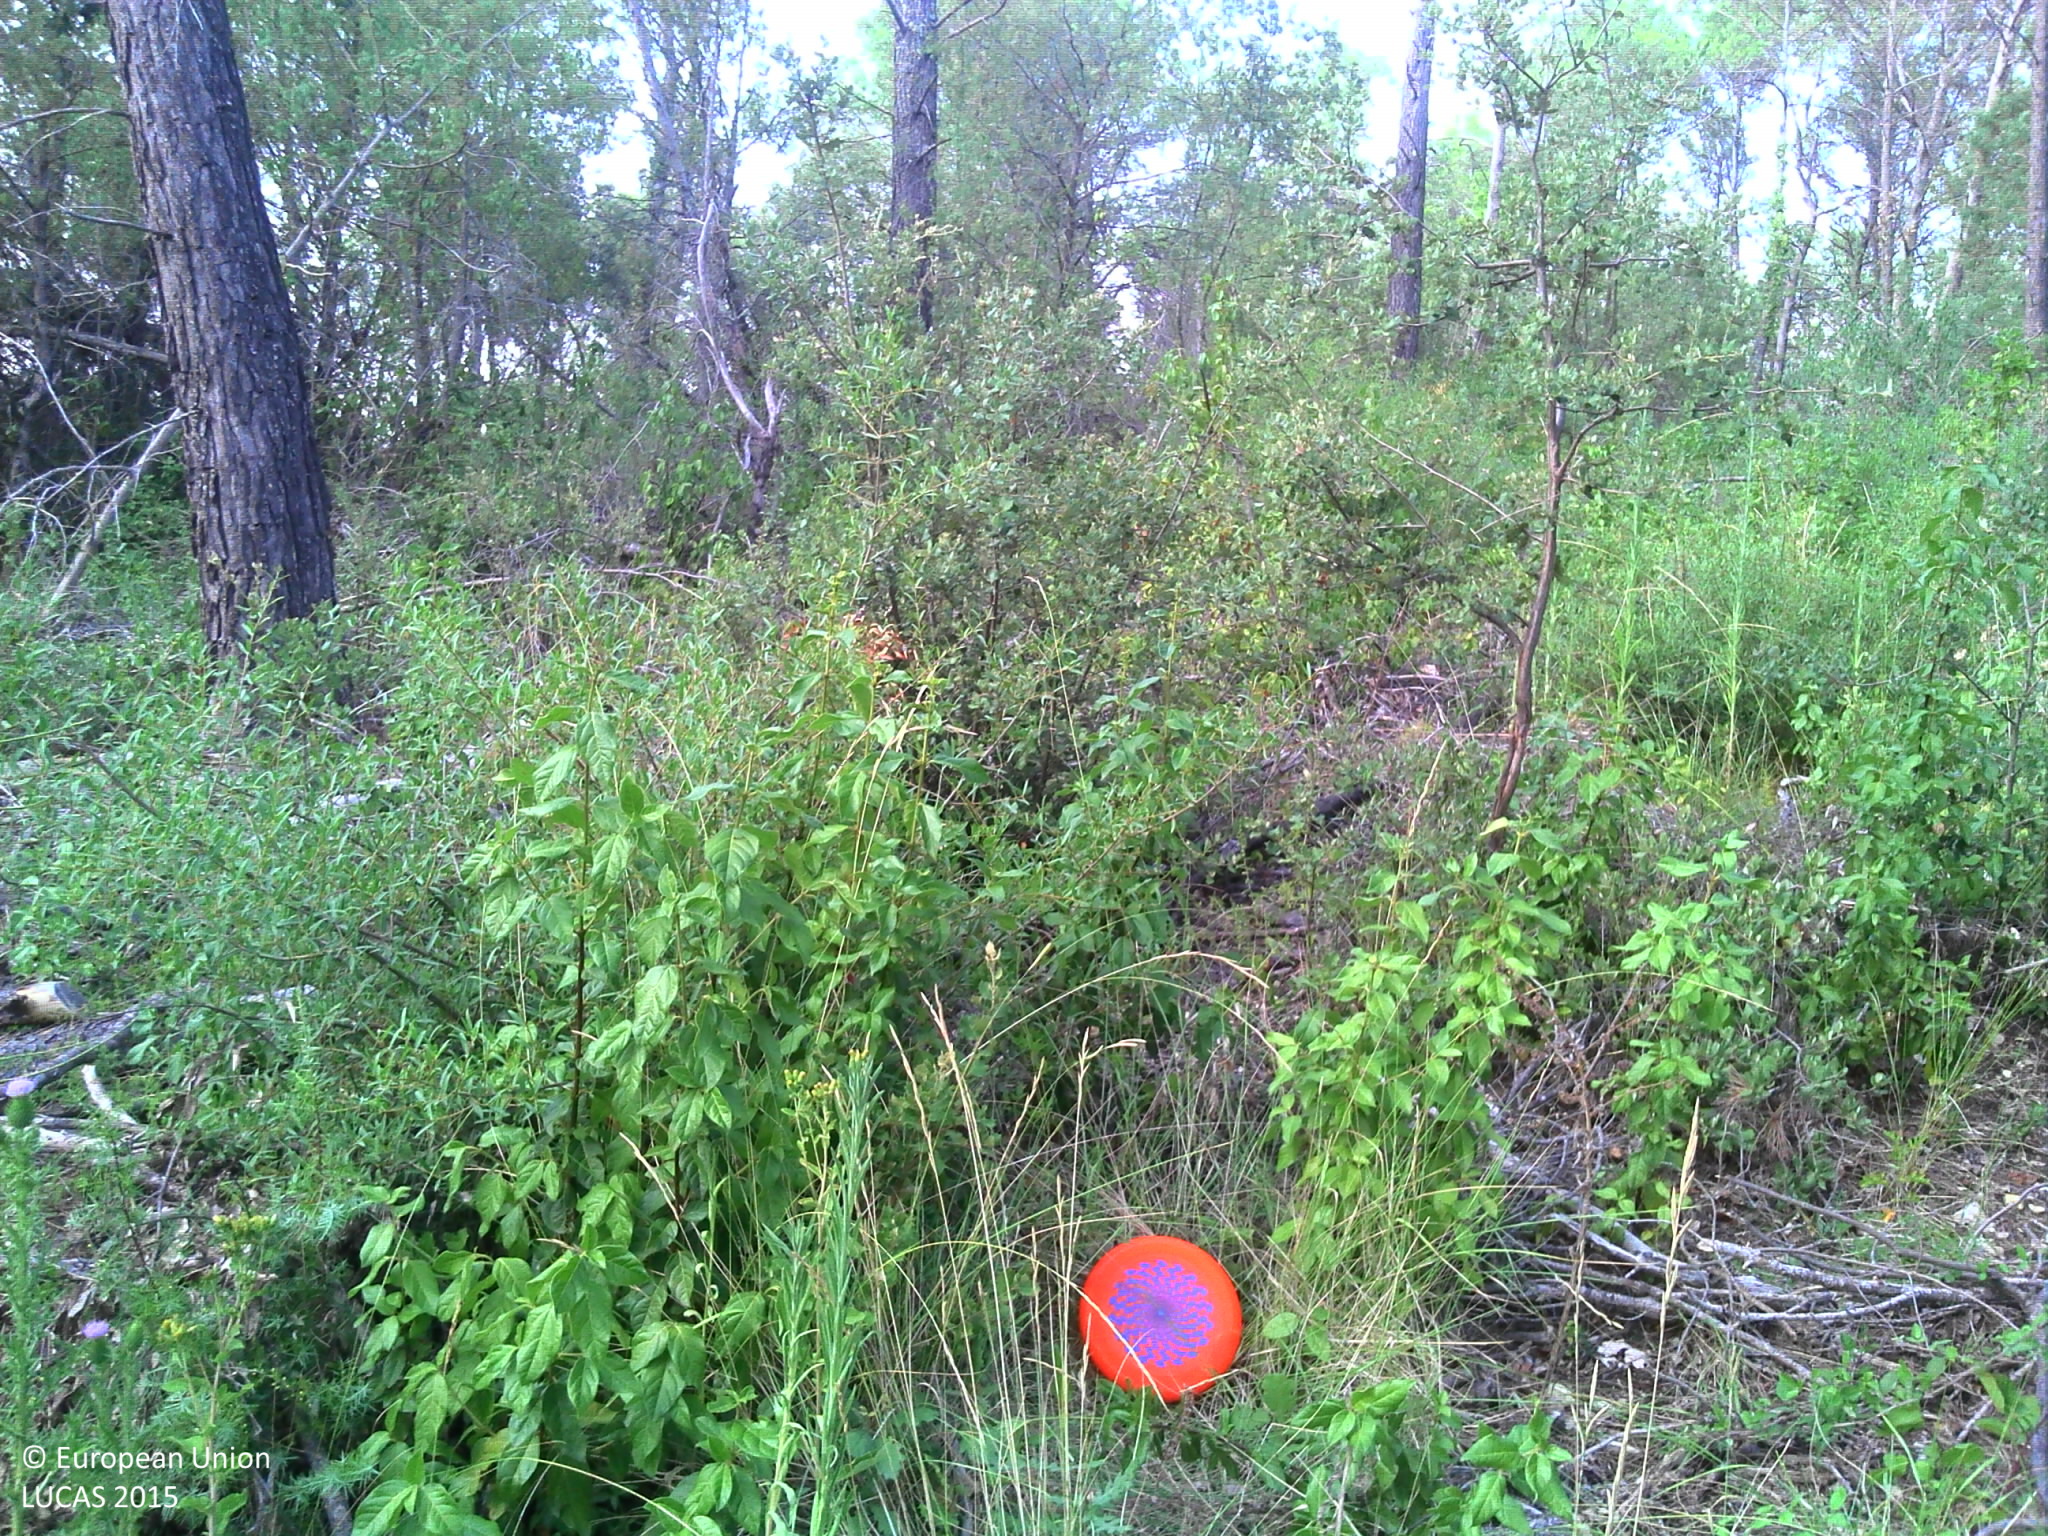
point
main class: Woodland
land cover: Pine dominated mixed woodland
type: coniferous forest of the mediterranean region
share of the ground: > 75 %
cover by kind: coniferous forest trees 50 %, broadleaved forest trees 25 %, shrubs 25 %
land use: Forestry
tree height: > 5 m
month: August
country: FR
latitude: 43.5256
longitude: 6.2846
